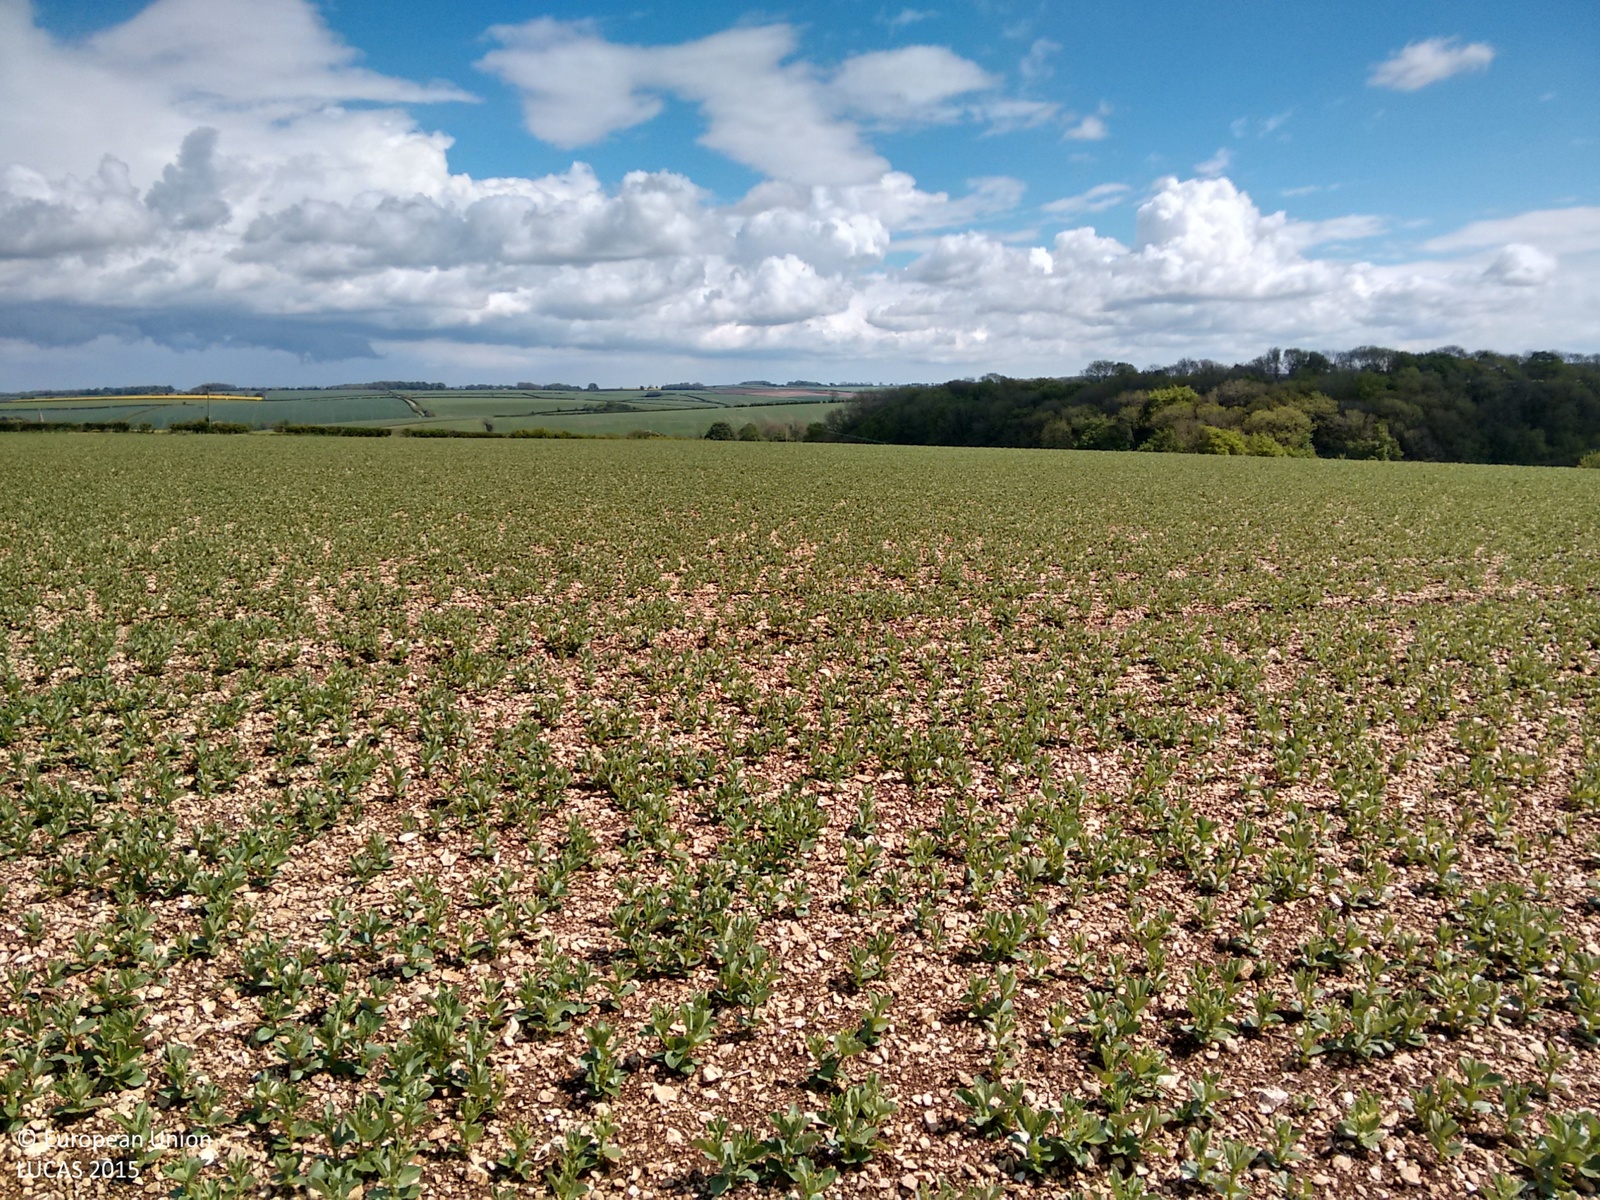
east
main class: Cropland
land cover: Dry pulses
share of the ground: 25 - 50 %
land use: Agriculture (excluding fallow land and kitchen gardens)
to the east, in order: Dry pulses; Grass margins
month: May
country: GB
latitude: 53.4240
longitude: -0.1916
